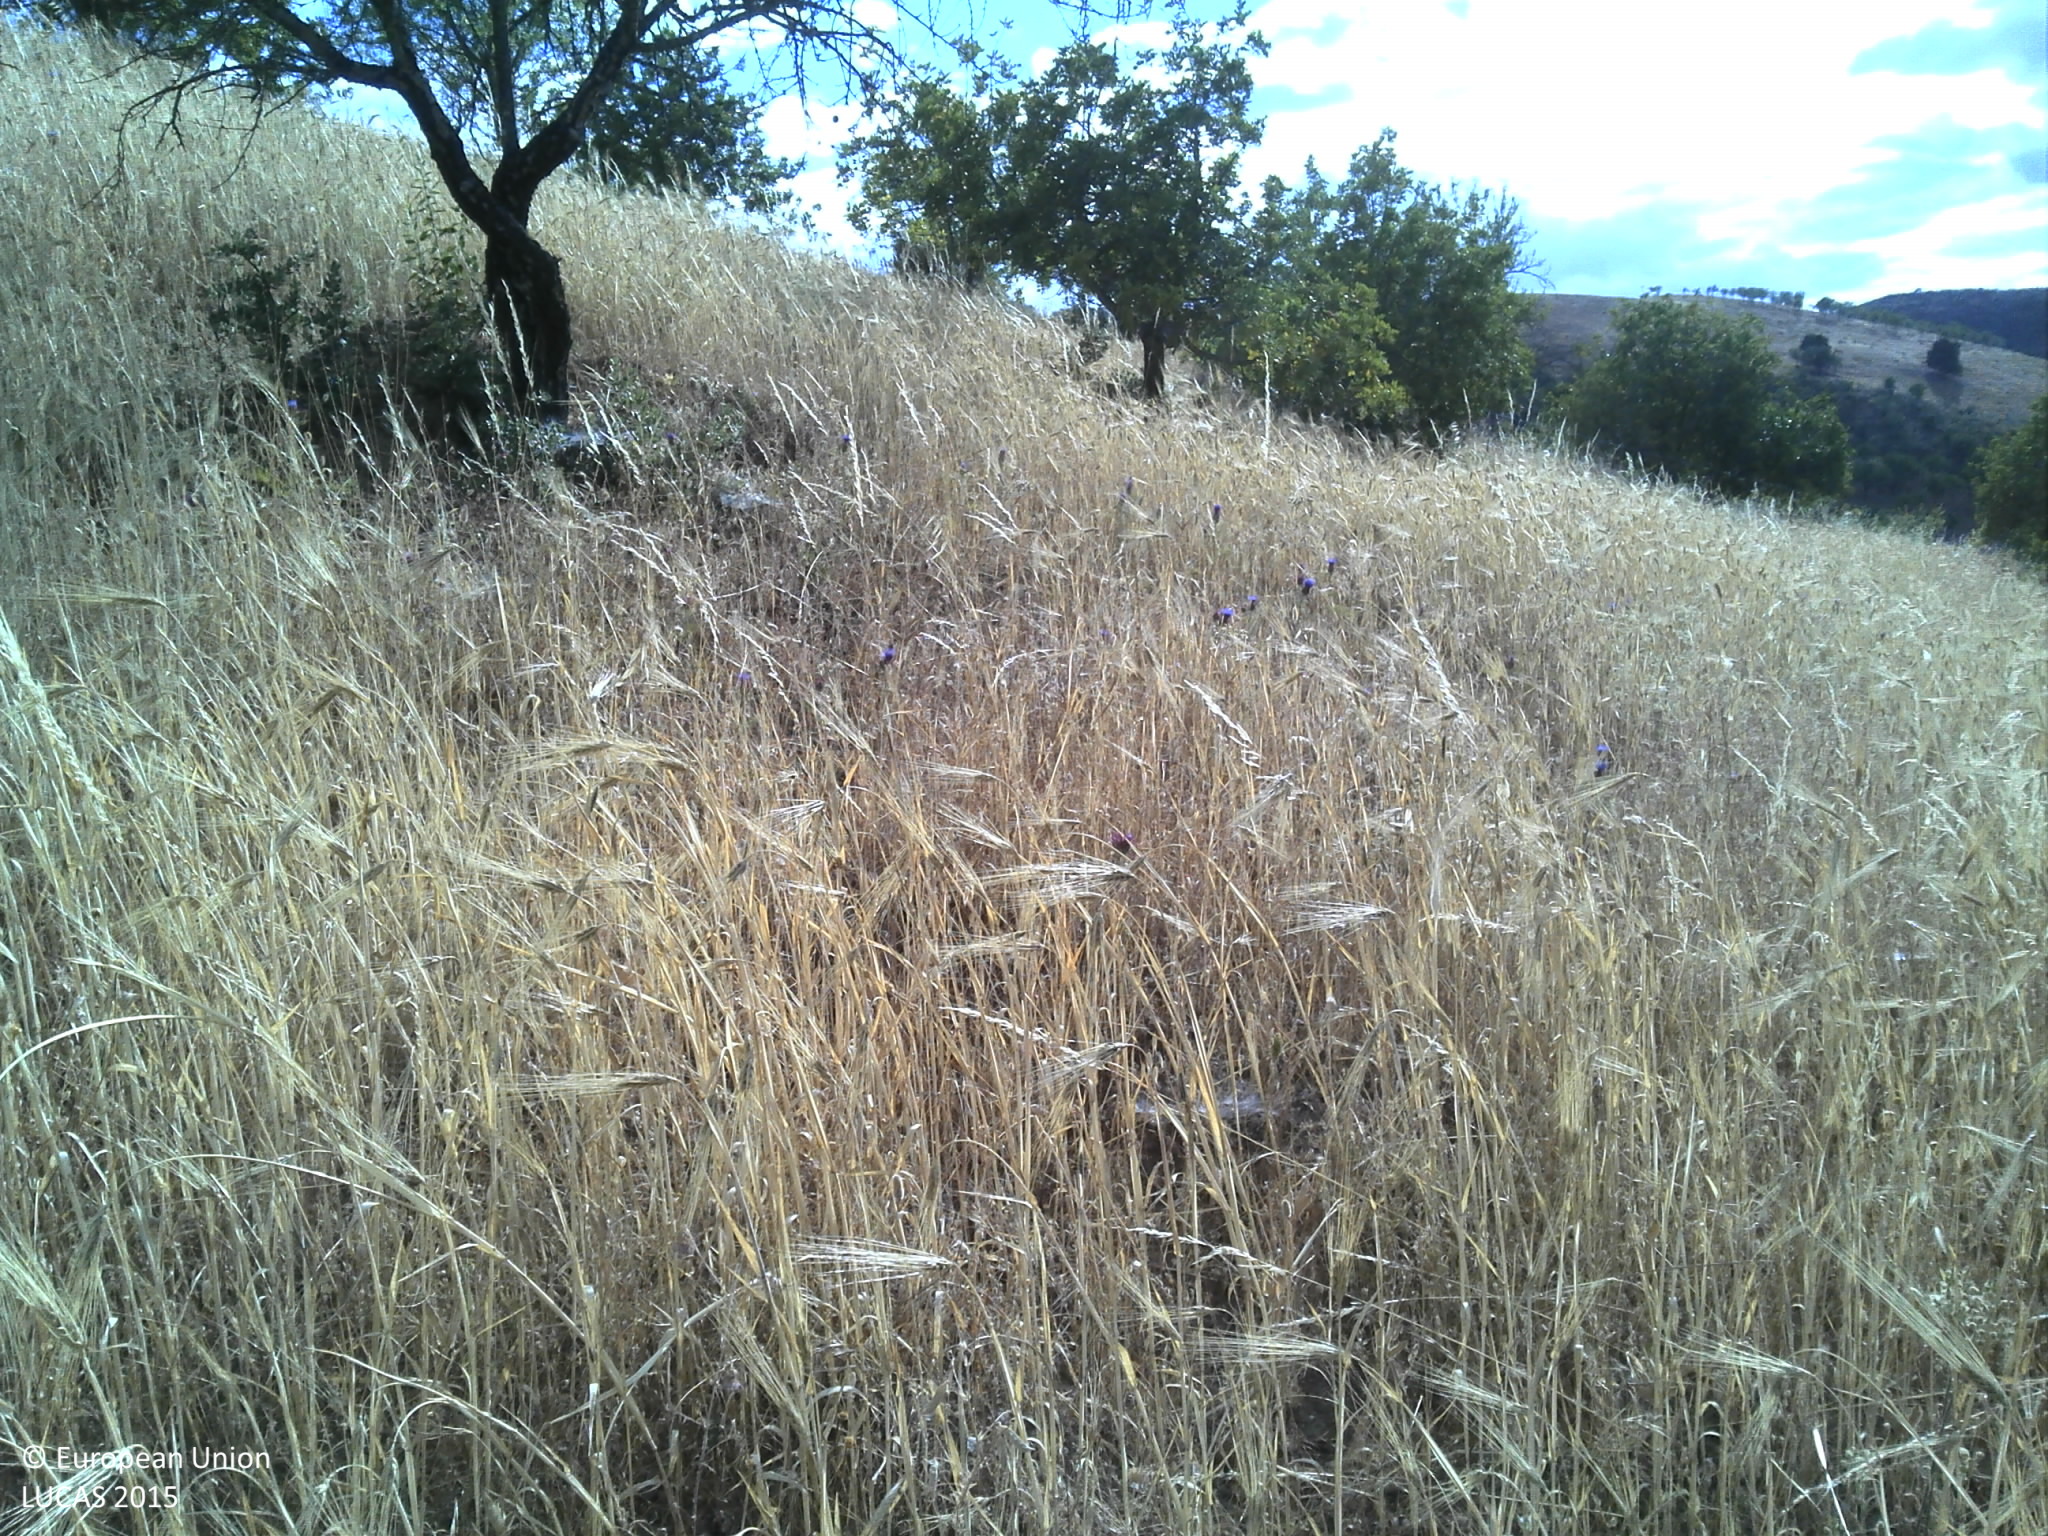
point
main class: Cropland
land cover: Nuts trees
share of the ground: 25 - 50 %
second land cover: Barley
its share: > 75 %
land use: Agriculture (excluding fallow land and kitchen gardens)
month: June
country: PT
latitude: 37.3277
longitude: -7.7176
